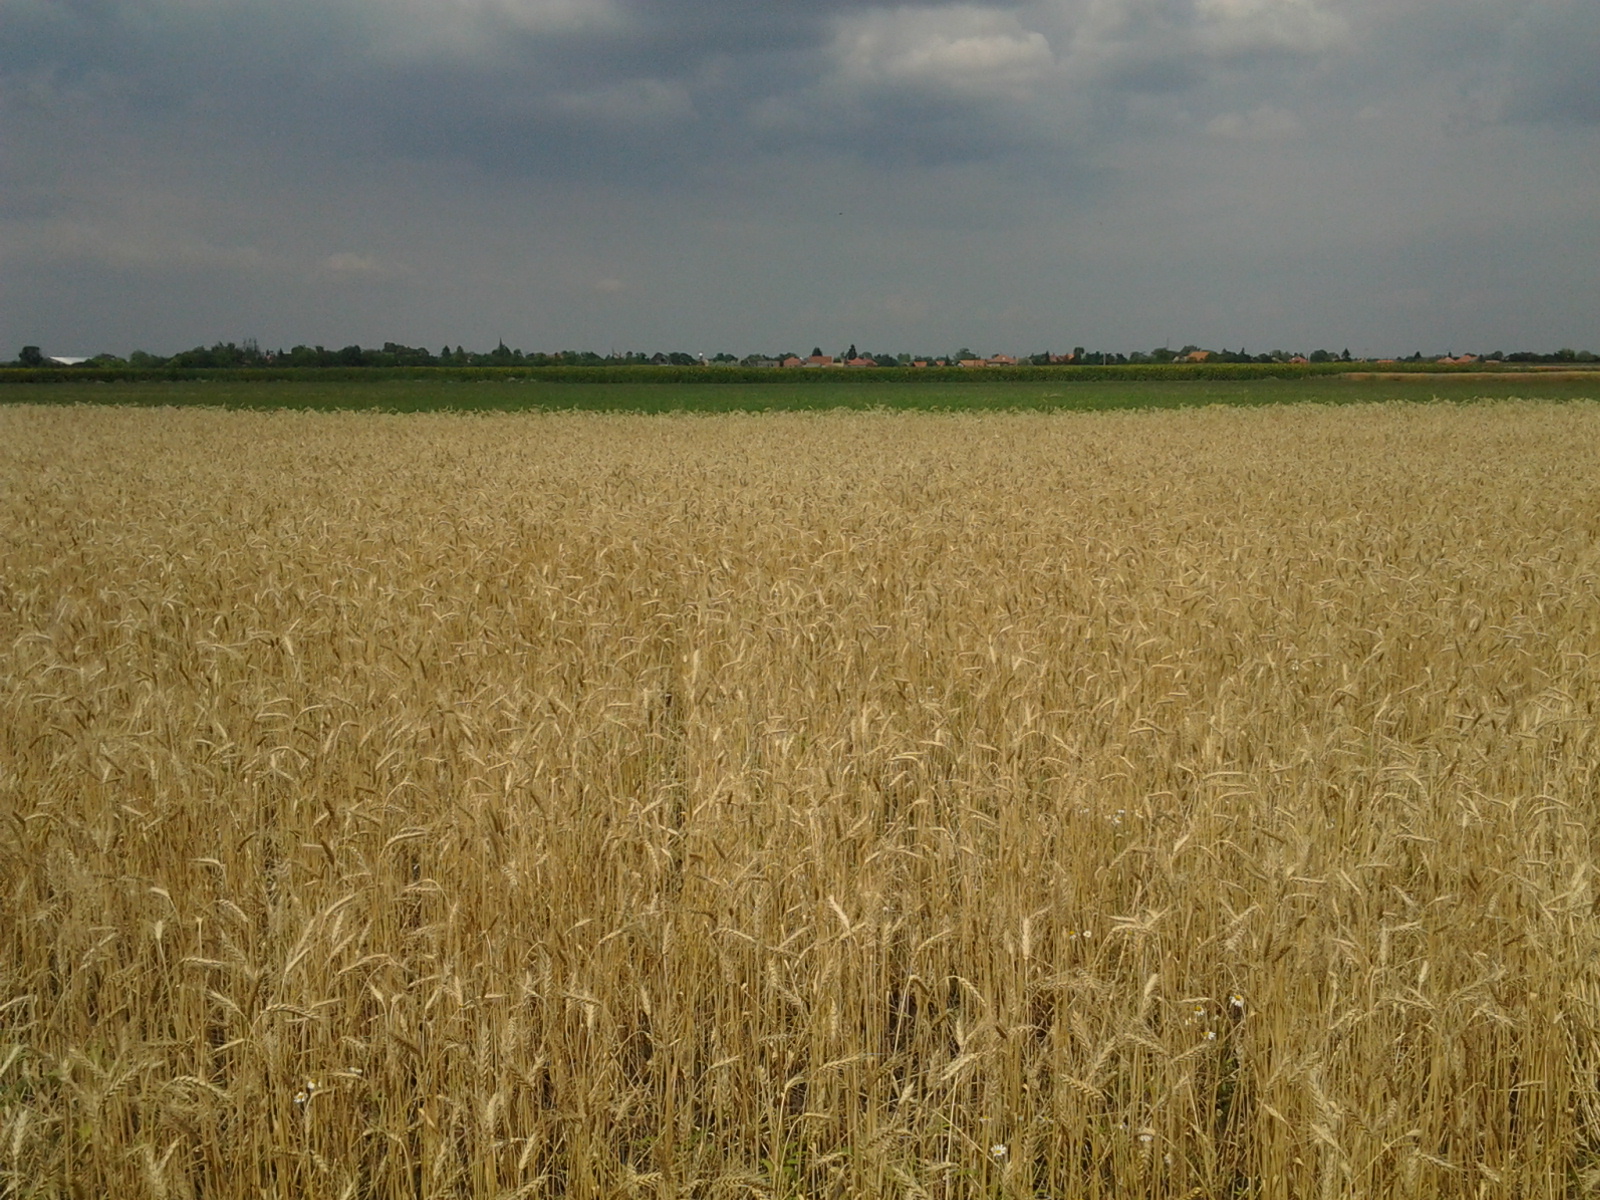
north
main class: Cropland
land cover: Triticale
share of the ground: > 75 %
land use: Agriculture (excluding fallow land and kitchen gardens)
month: June
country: HU
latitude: 47.4385
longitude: 20.2247
